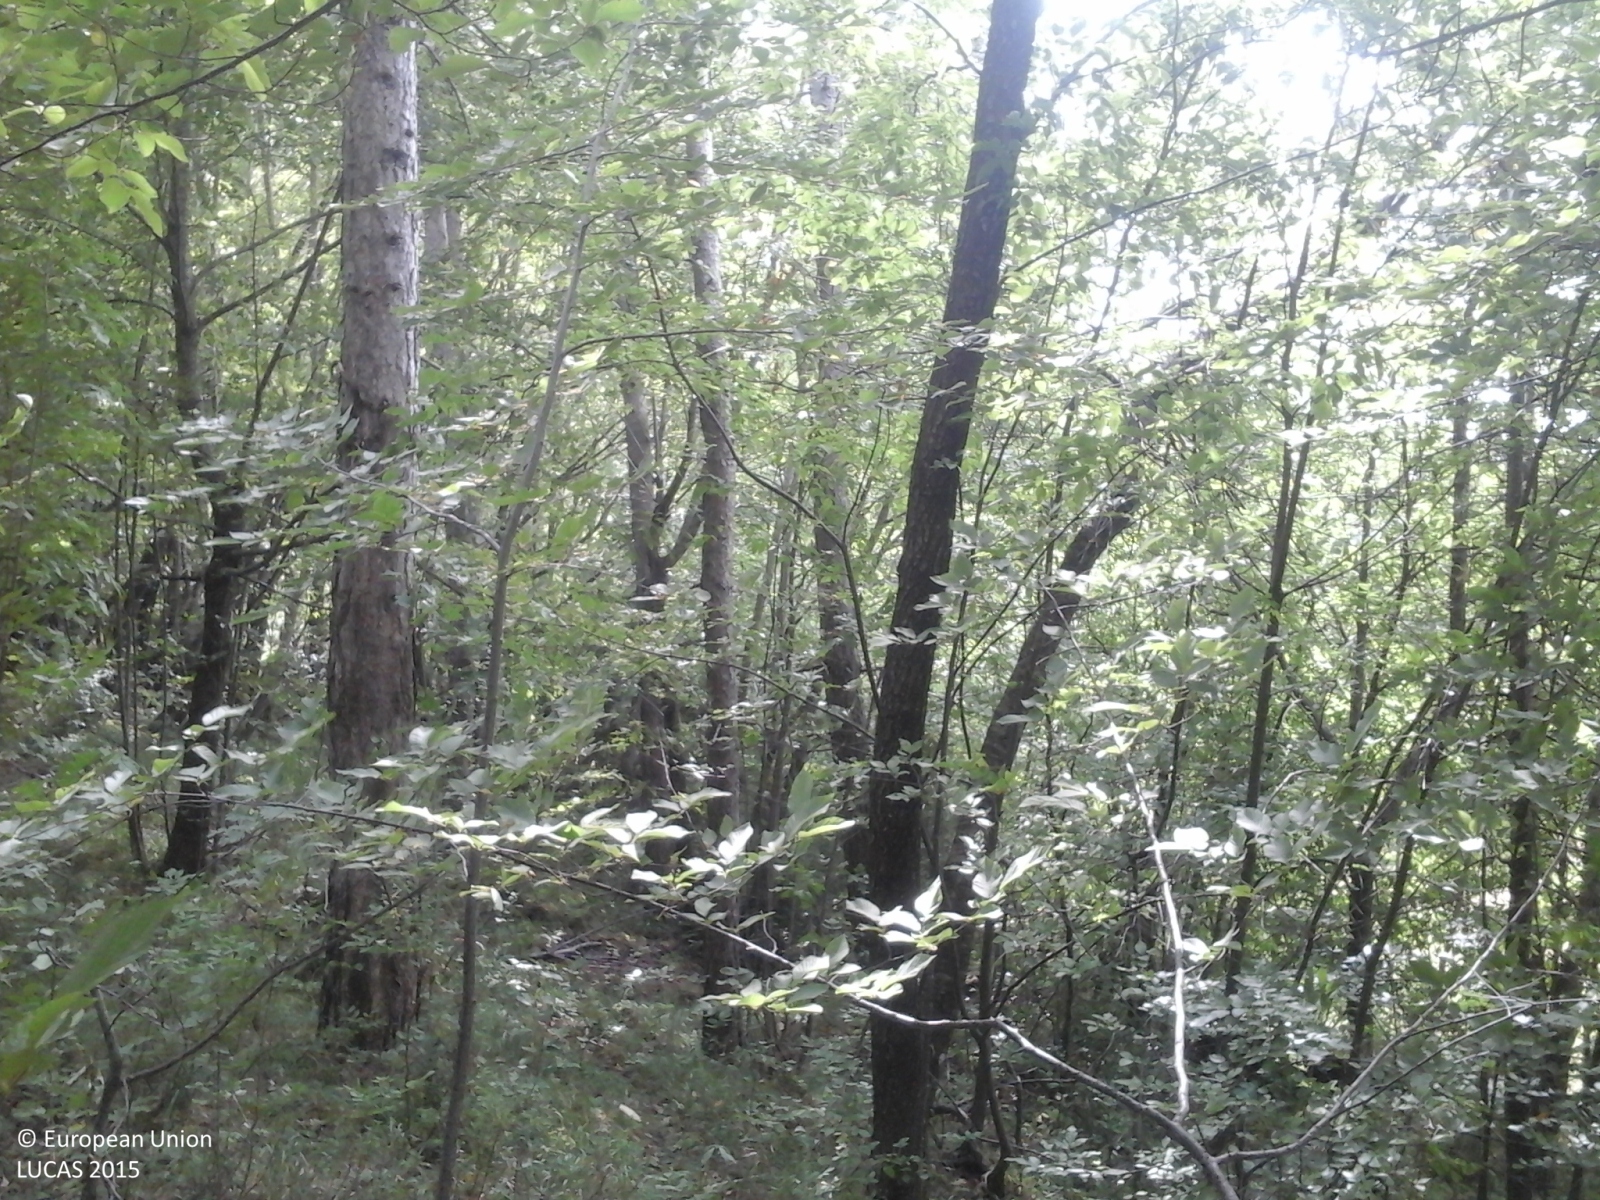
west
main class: Woodland
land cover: Pine dominated mixed woodland
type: coniferous forest of the mediterranean region
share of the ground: > 75 %
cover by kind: coniferous forest trees 75 %, broadleaved forest trees 25 %
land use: Forestry
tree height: > 5 m
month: July
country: IT
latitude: 44.4044
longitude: 10.2380
